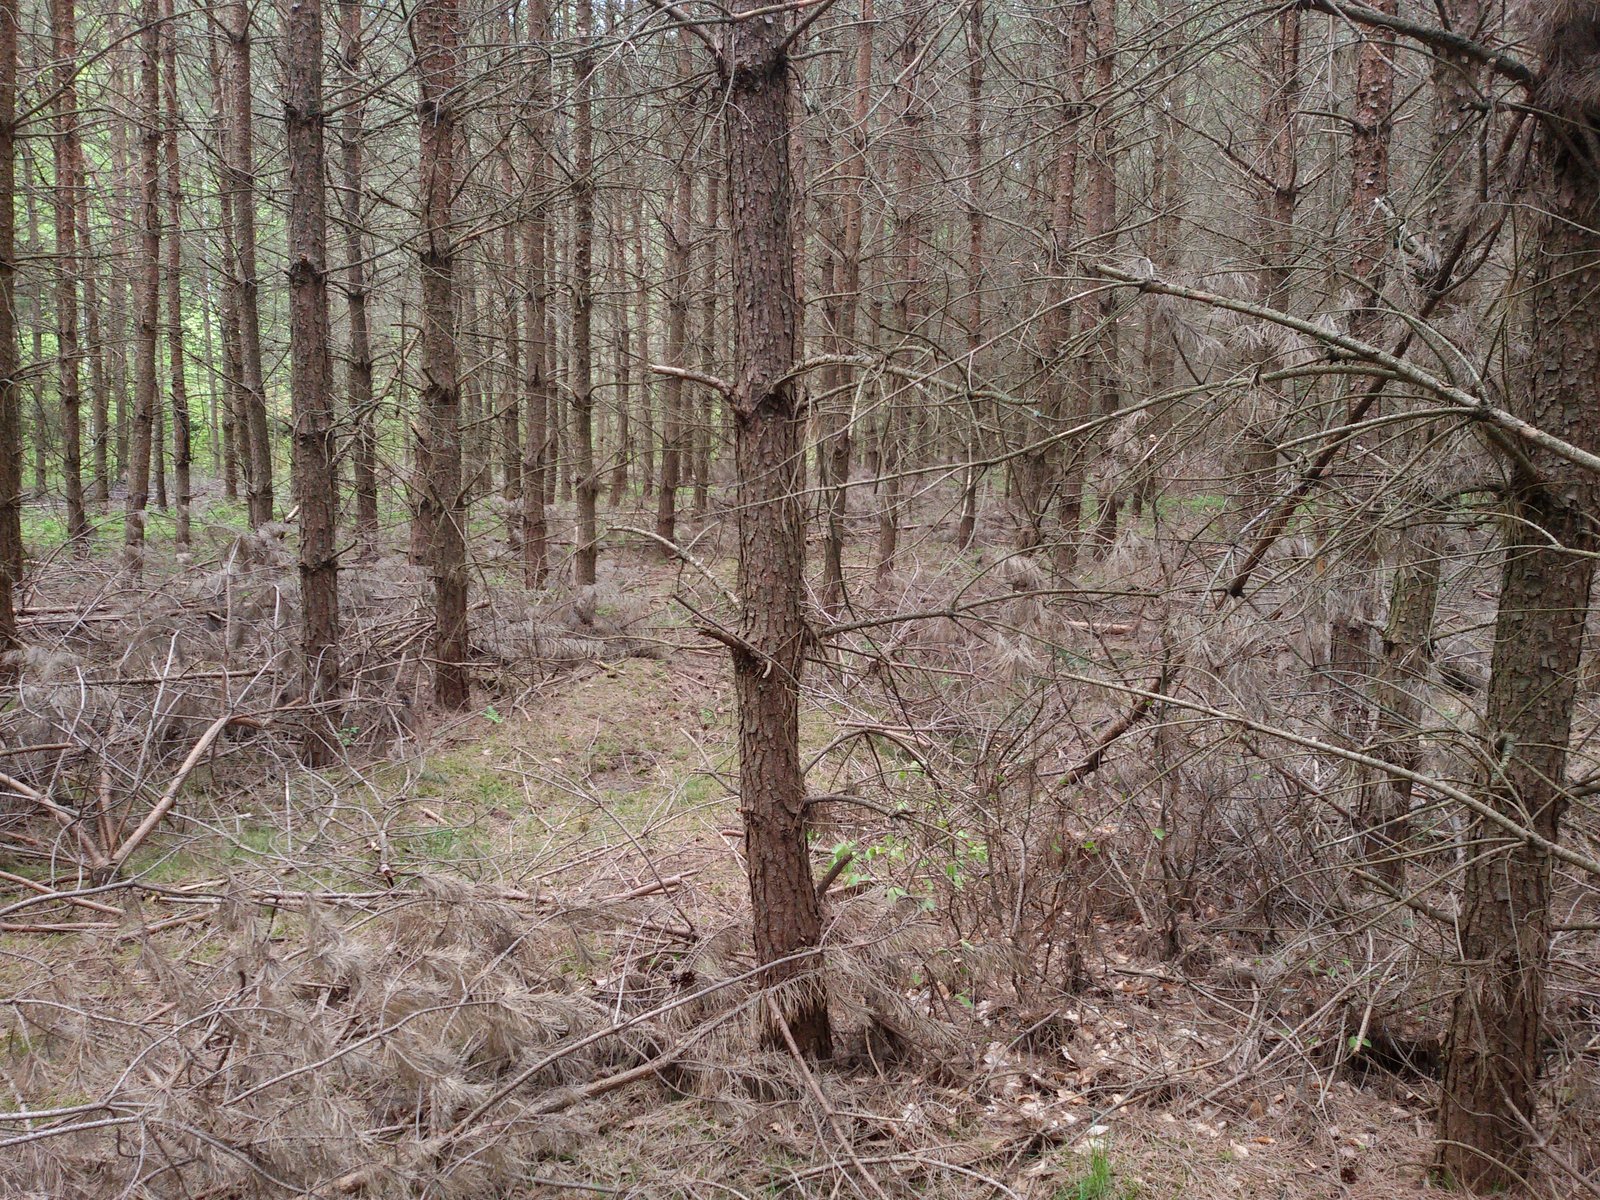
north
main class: Woodland
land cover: Pine dominated coniferous woodland
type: hemiboreal forest and nemoral coniferous forest and mixed broadleaved-coniferous forest
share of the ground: > 75 %
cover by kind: coniferous forest trees 90 %, lichens and mosses 10 %
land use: Forestry
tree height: > 5 m
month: May
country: PL
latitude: 53.4175
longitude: 17.2779
